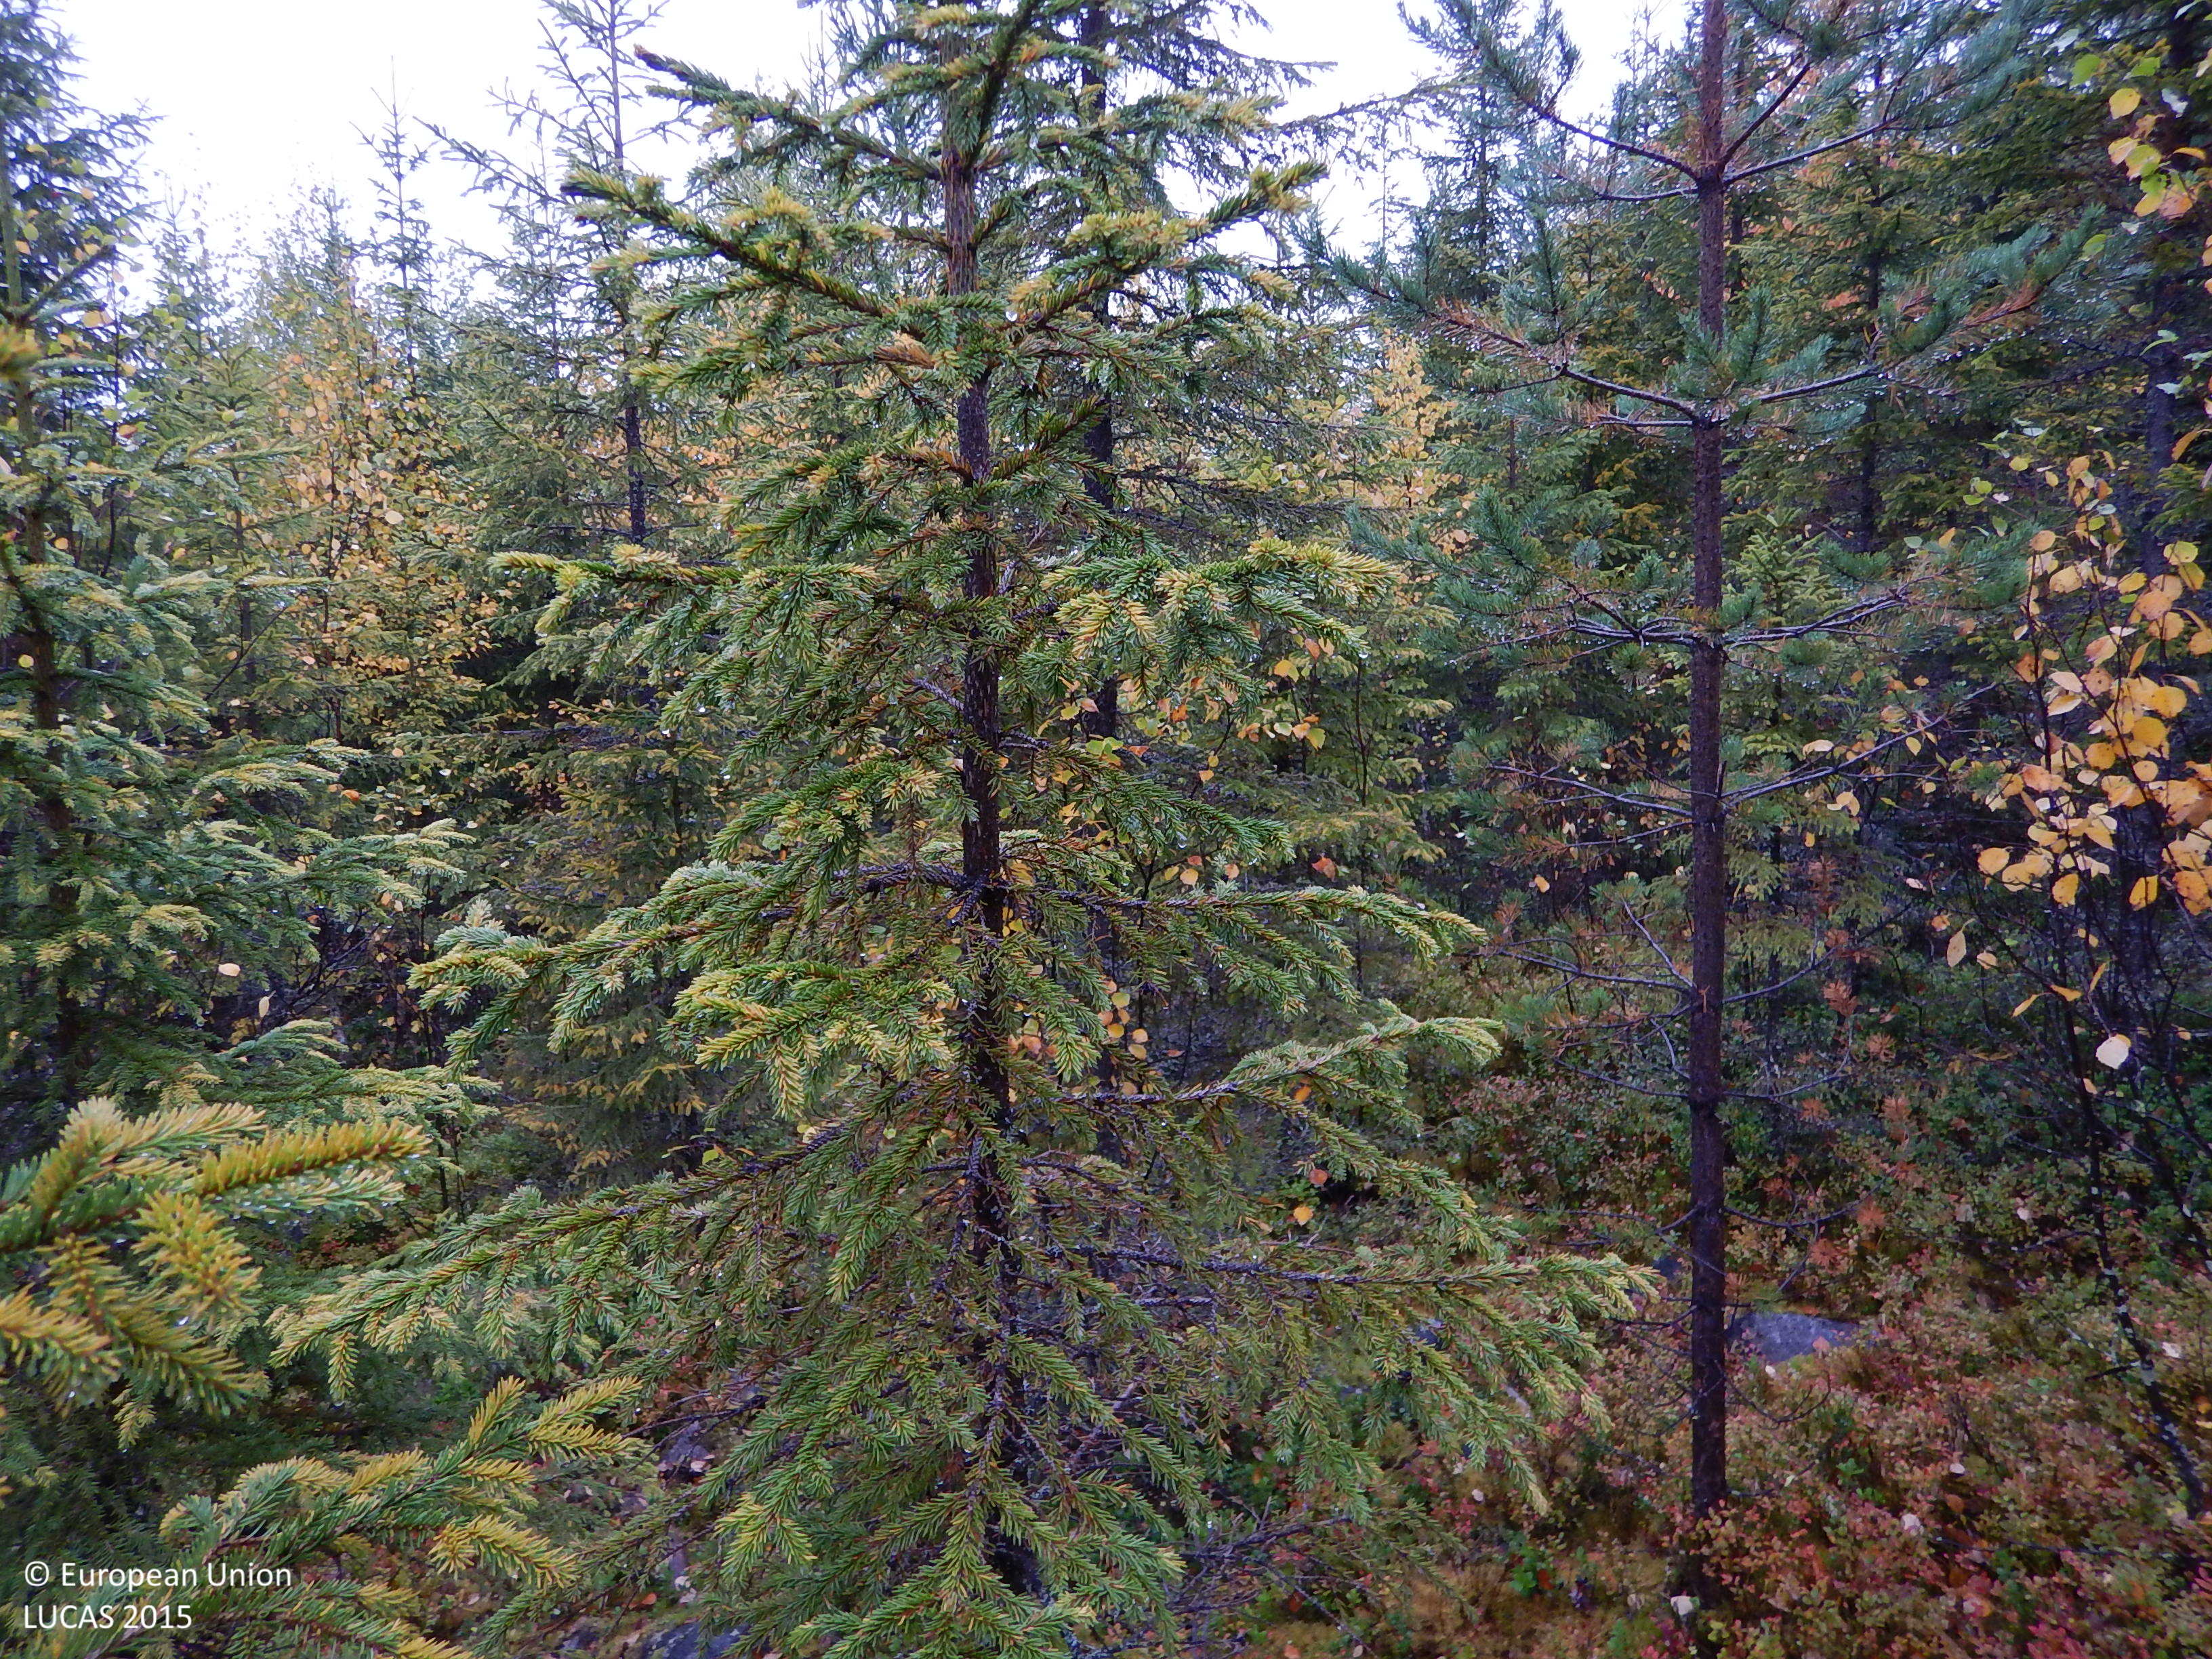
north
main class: Woodland
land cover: Spruce dominated coniferous woodland
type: boreal forest
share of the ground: 50 - 75 %
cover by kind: coniferous forest trees 55 %, lichens and mosses 20 %, shrubs 15 %, broadleaved forest trees 5 %, herbaceous plants 5 %
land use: Forestry
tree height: < 5 m
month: September
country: SE
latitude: 65.0371
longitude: 18.9478
